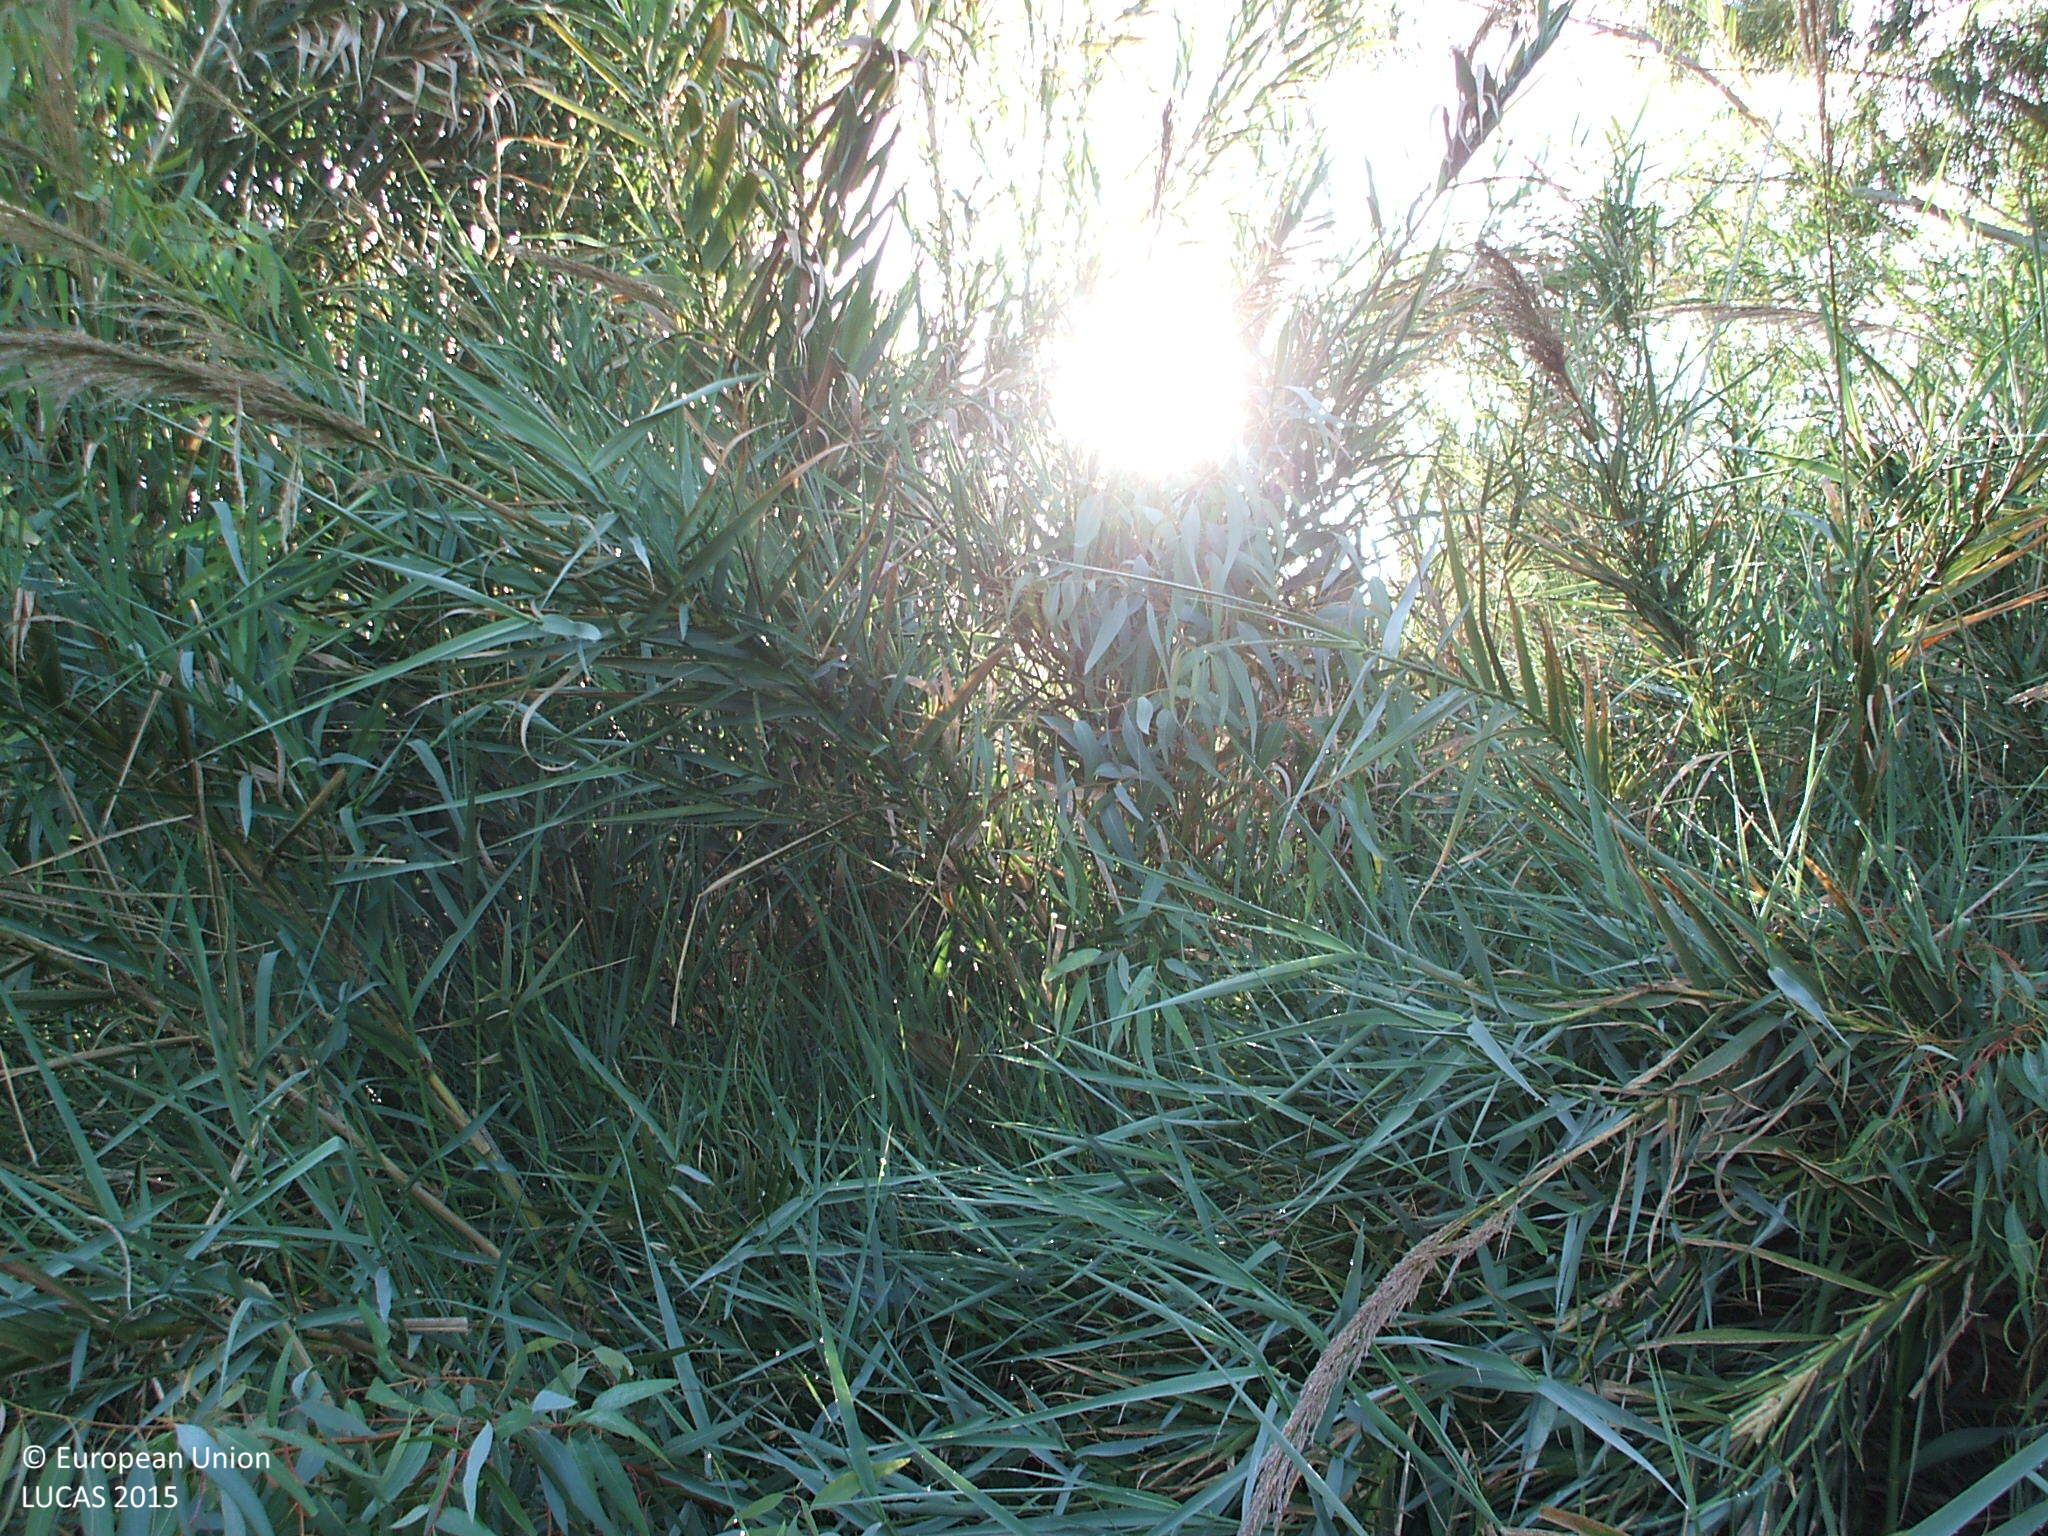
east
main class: Woodland
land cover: Broadleaved woodland
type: exotic forest
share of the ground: 10 - 25 %
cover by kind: shrubs 85 %, broadleaved forest trees 15 %
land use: Semi-natural and natural areas not in use
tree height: > 5 m
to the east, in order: Broadleaved woodland; Rivers and streams; Broadleaved woodland; Permanent crops (only in case pi); Tracks; Permanent crops (only in case pi); Tracks; Permanent crops (only in case pi)
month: April
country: ES
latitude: 37.6088
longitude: -5.6205
